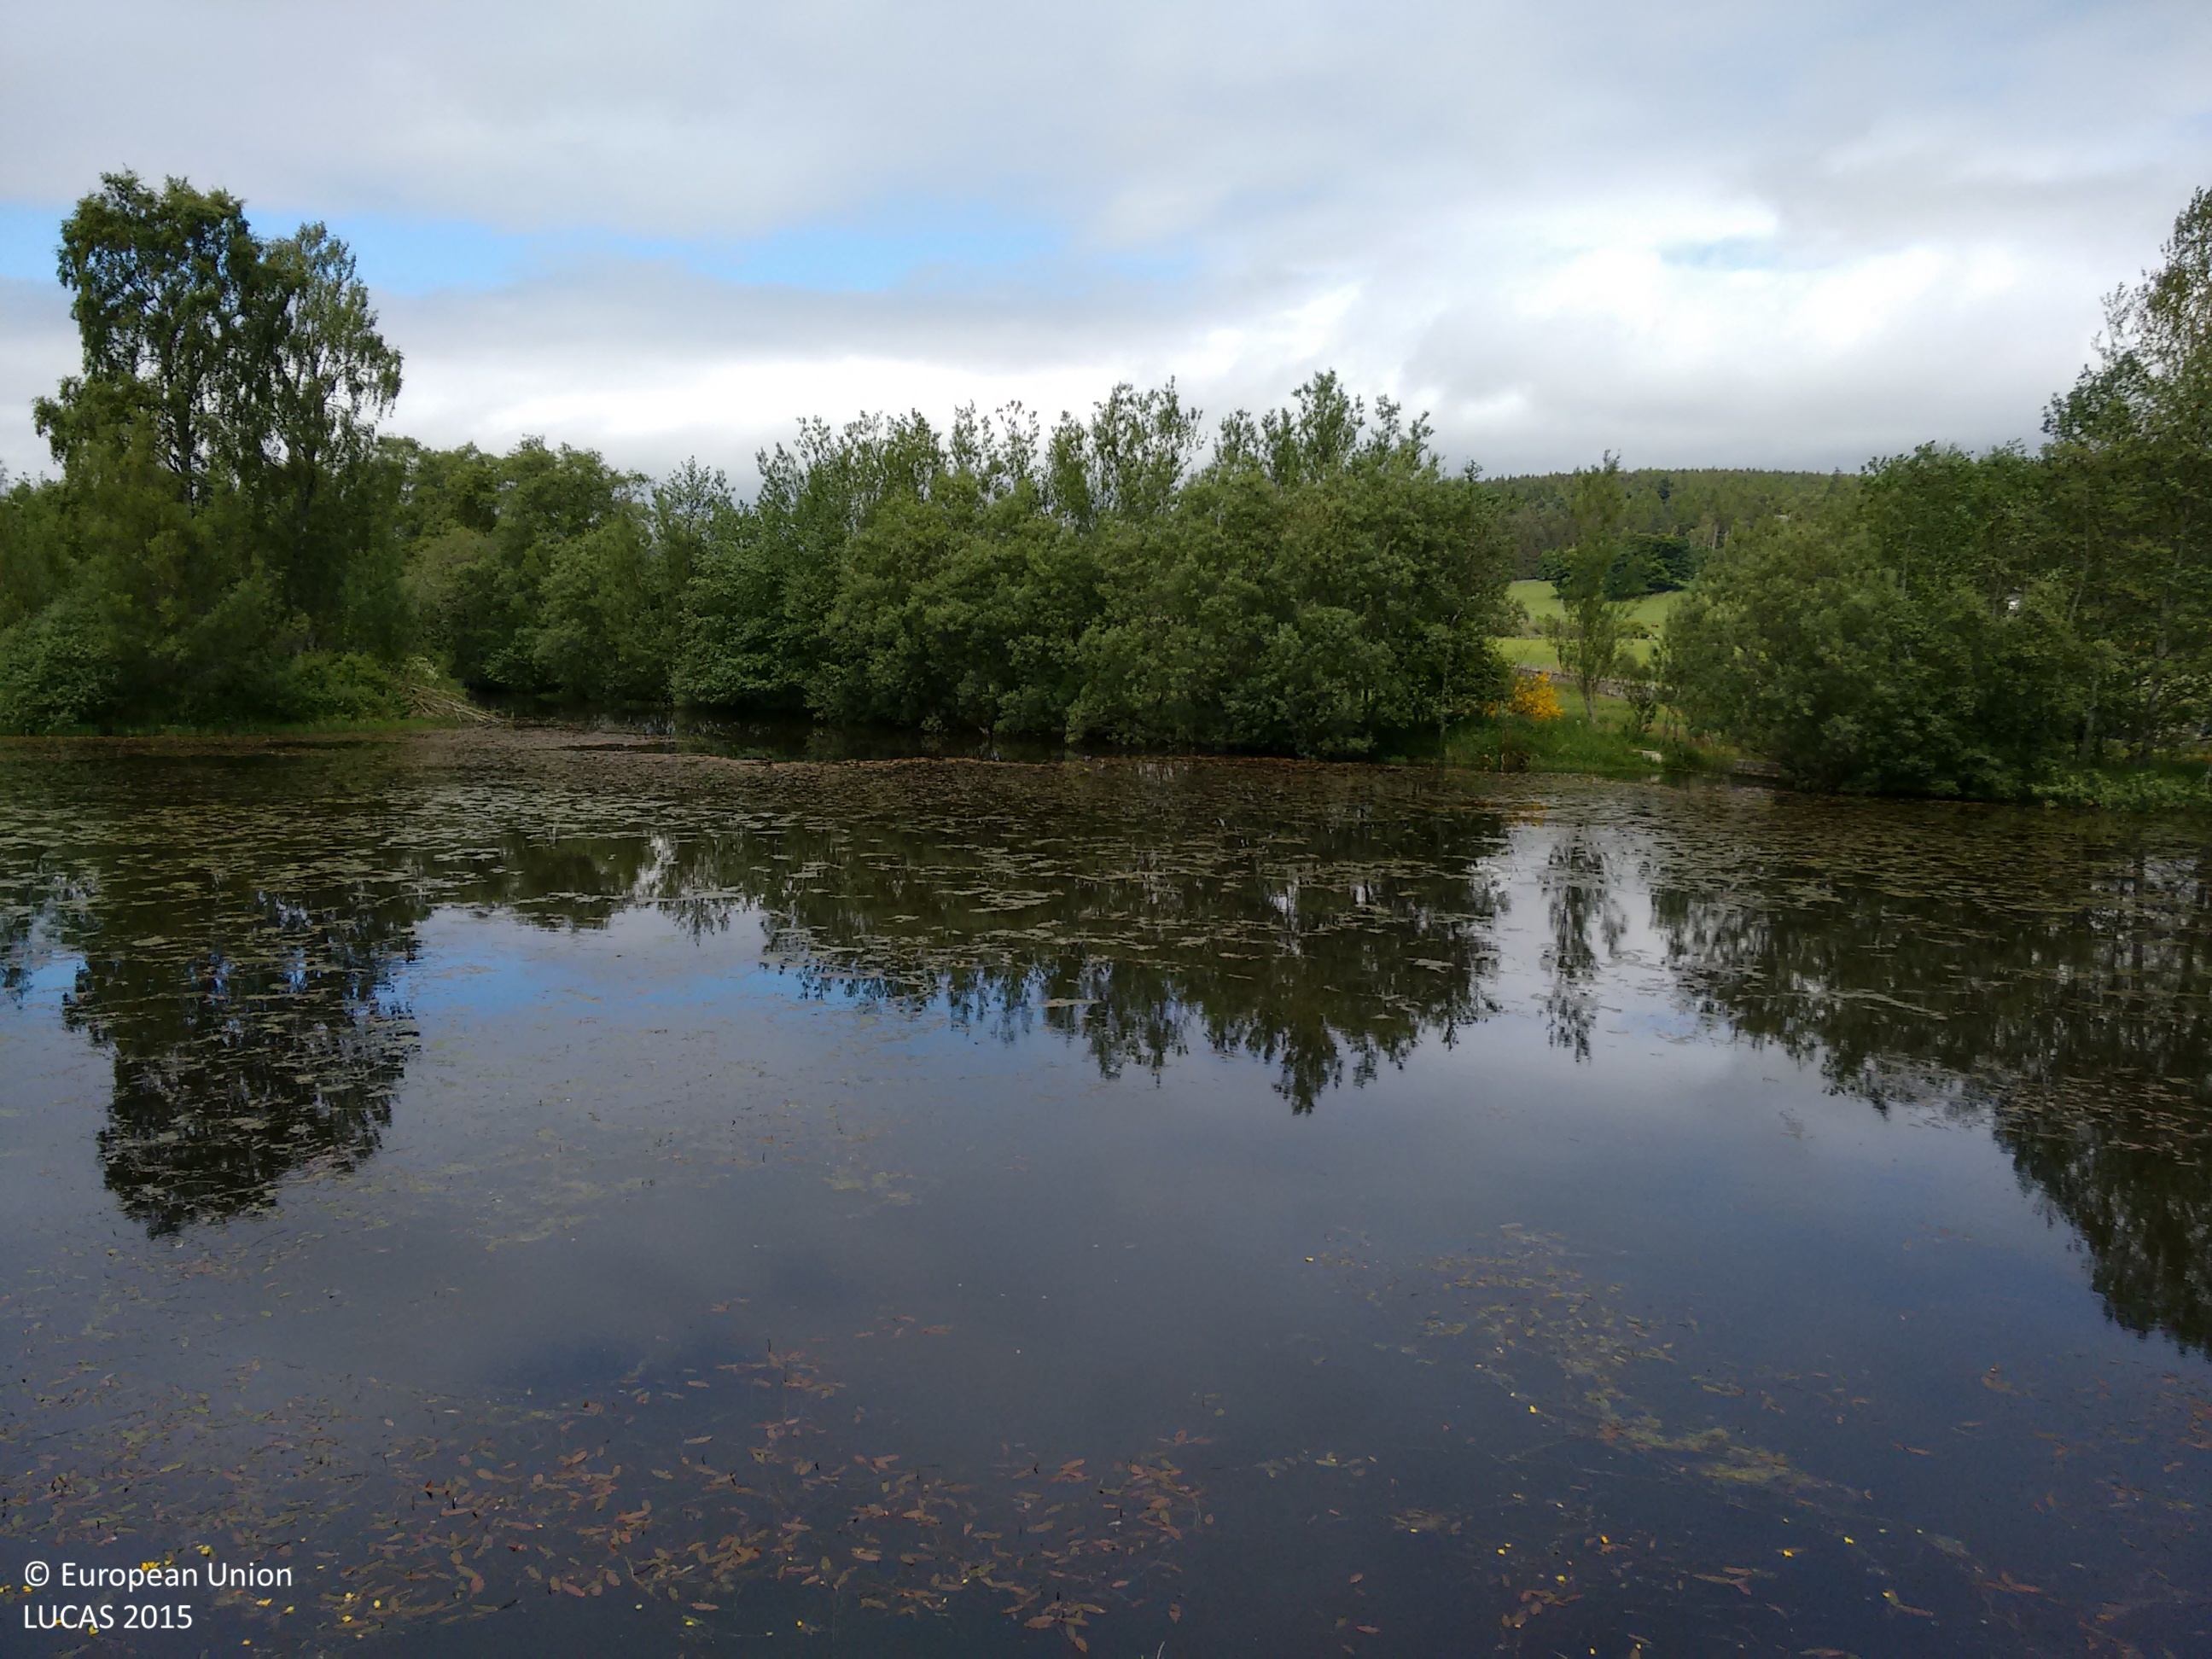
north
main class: Shrubland
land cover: Shrubland without tree cover
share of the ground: > 75 %
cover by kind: shrubs 75 %, herbaceous plants 25 %
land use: Semi-natural and natural areas not in use
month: June
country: GB
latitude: 57.0836
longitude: -2.7135
